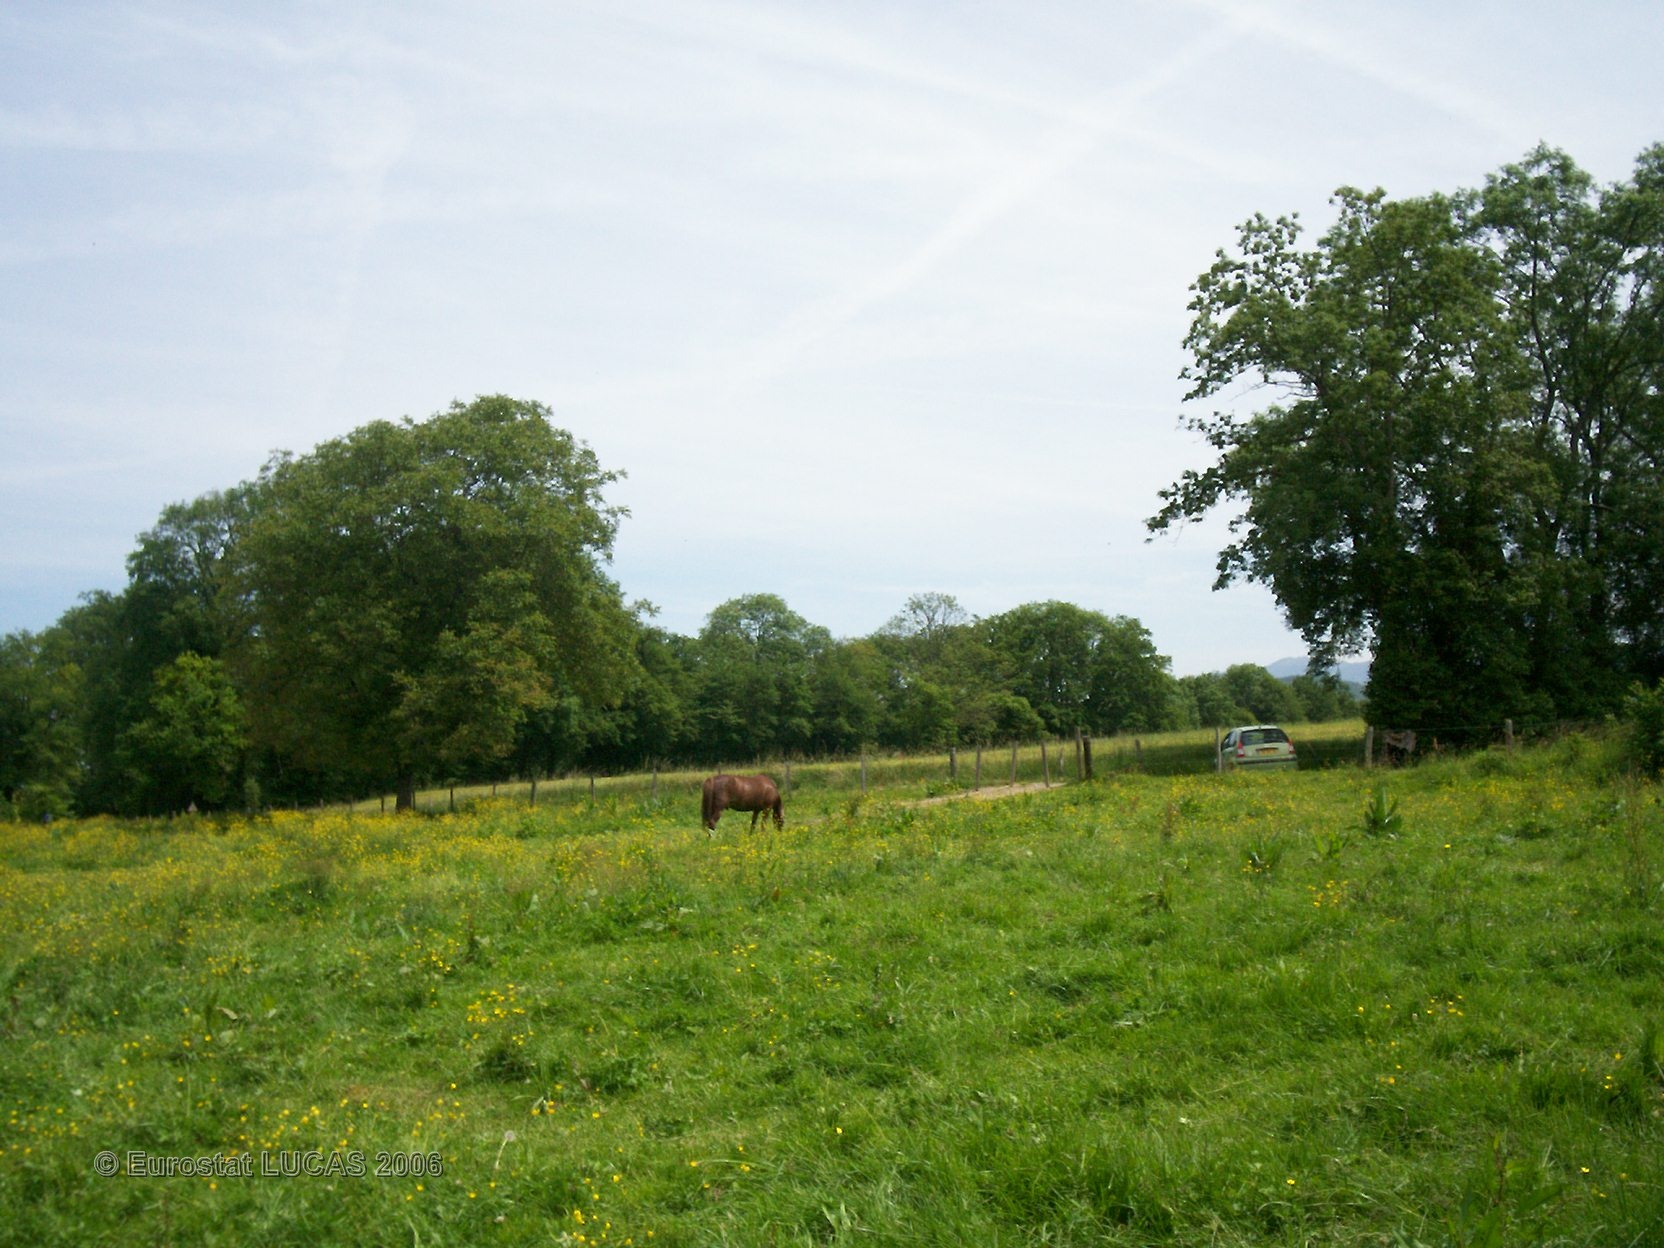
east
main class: Grassland
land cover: Grassland without tree/shrub cover
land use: Agriculture (excluding fallow land and kitchen gardens)
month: June
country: FR
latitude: 46.3269
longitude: 6.4053
